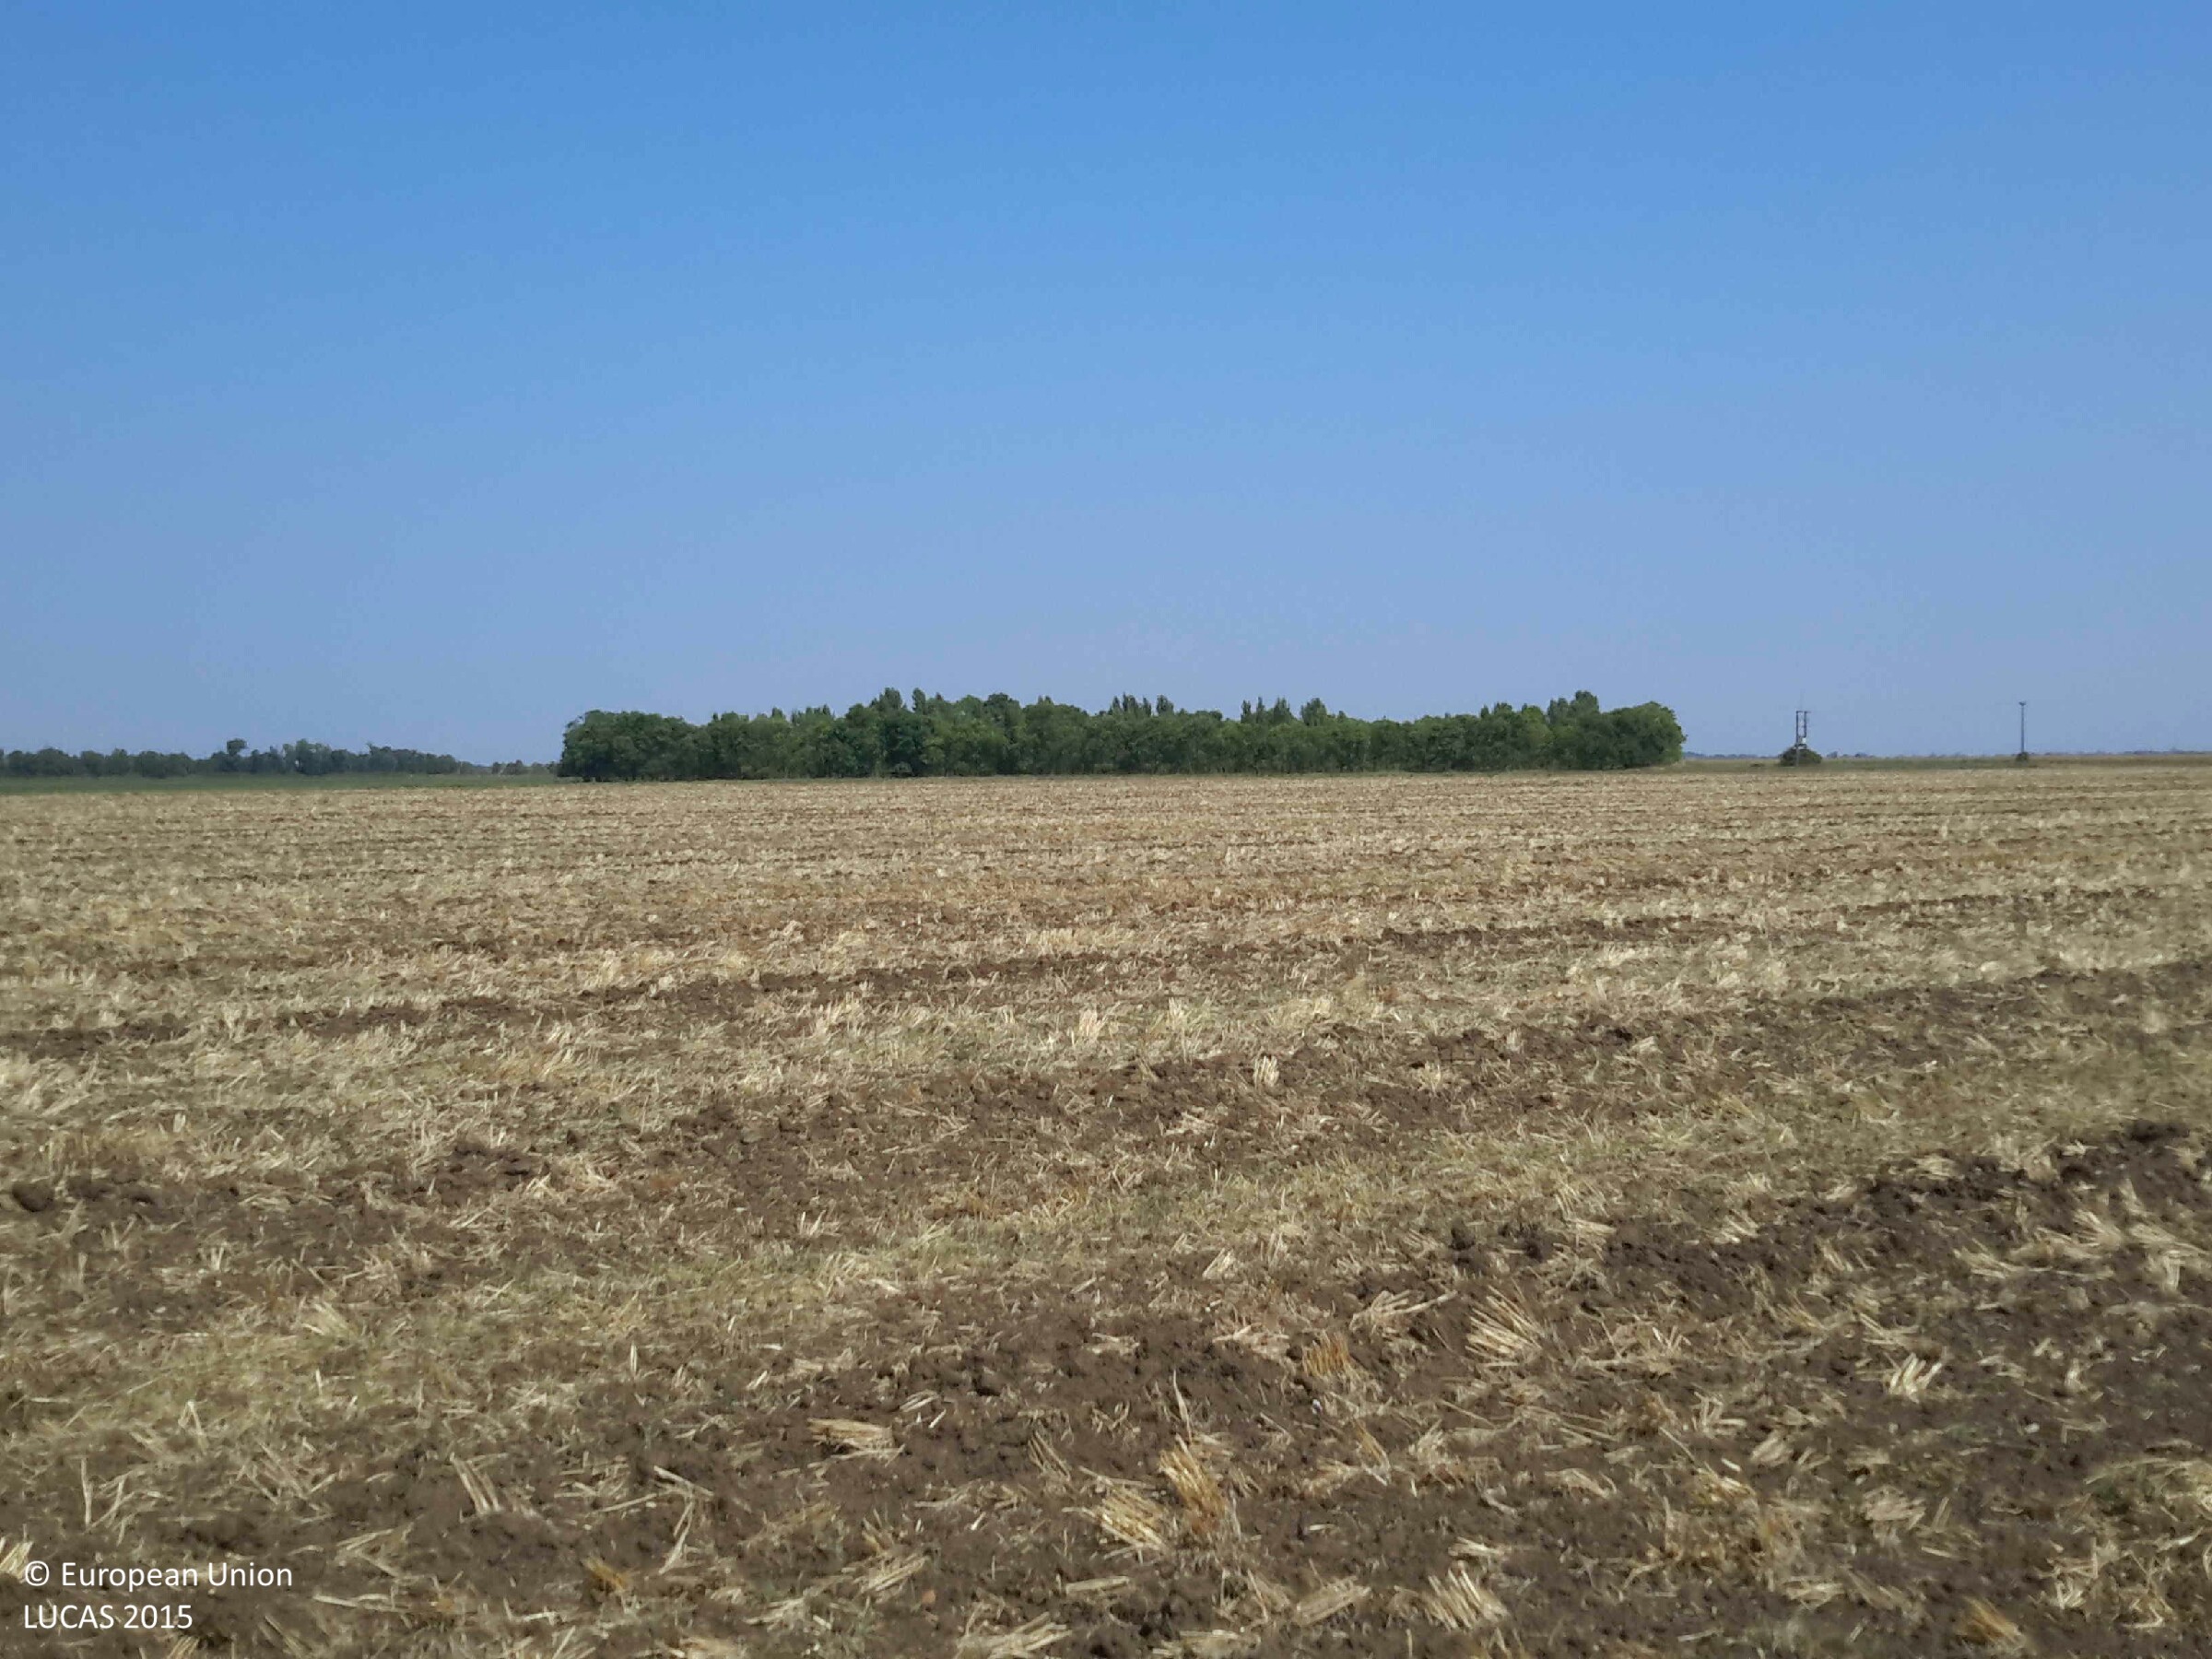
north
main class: Cropland
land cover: Durum wheat
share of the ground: < 10 %
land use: Agriculture (excluding fallow land and kitchen gardens)
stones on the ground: < 10 %
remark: Harvested field
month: August
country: HU
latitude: 47.8301
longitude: 17.1275
